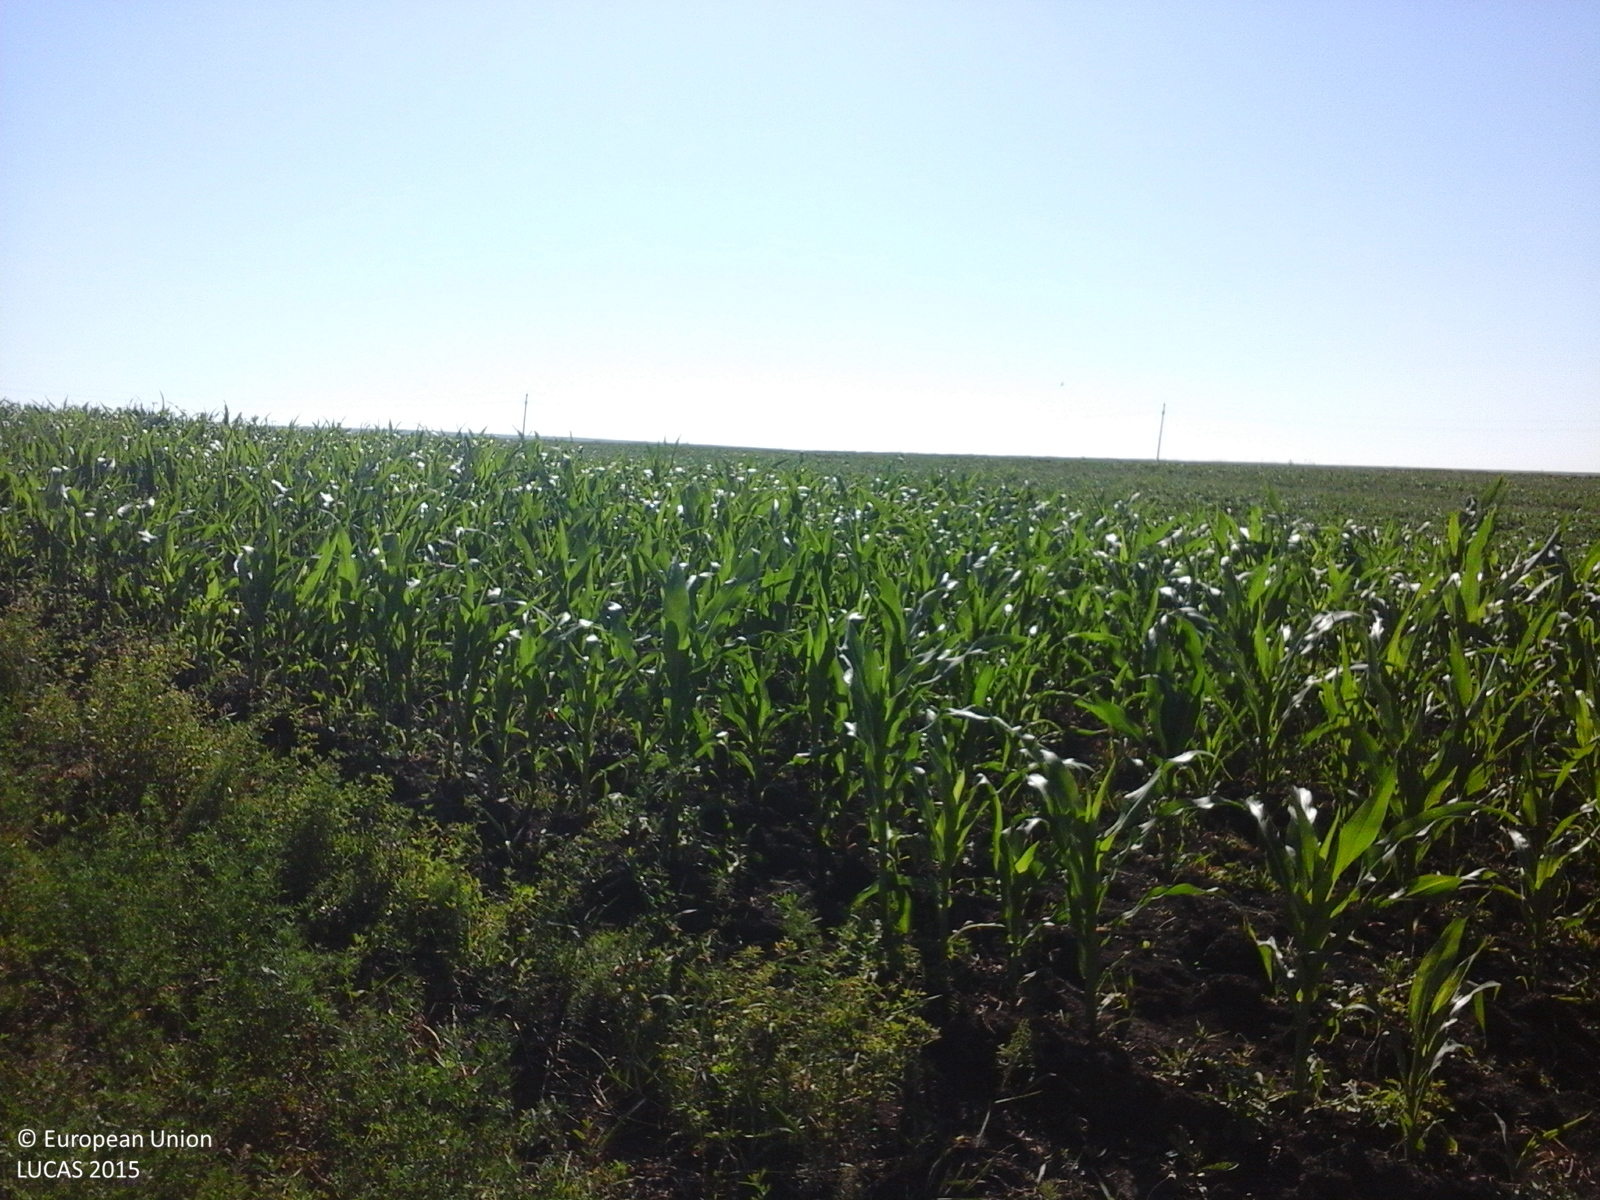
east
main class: Cropland
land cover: Lucerne
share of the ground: > 75 %
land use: Agriculture (excluding fallow land and kitchen gardens)
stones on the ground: < 10 %
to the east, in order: Lucerne; Maize; Soya; Electric lines; Grassland without tree/shrub cover
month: June
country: RO
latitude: 48.0213
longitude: 26.8212
